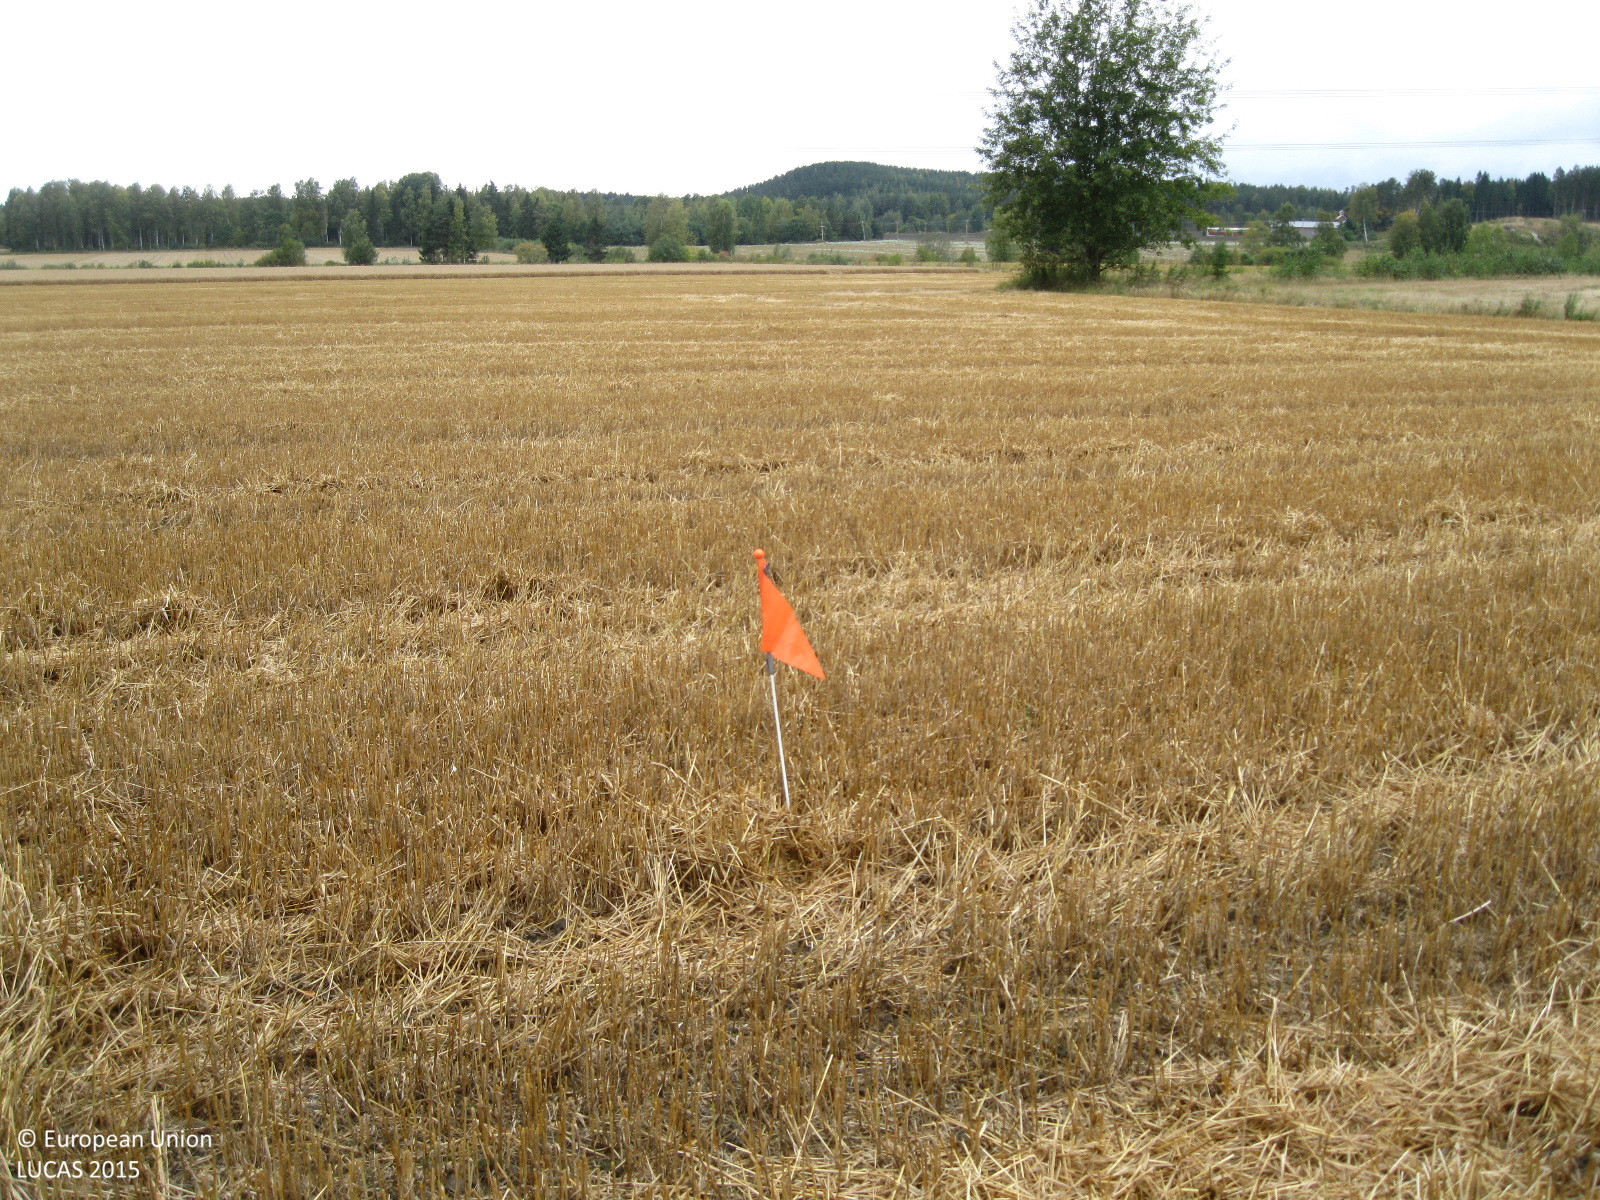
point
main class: Cropland
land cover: Barley
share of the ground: > 75 %
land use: Agriculture (excluding fallow land and kitchen gardens)
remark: Harvested field
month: September
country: FI
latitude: 60.8511
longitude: 24.7407
